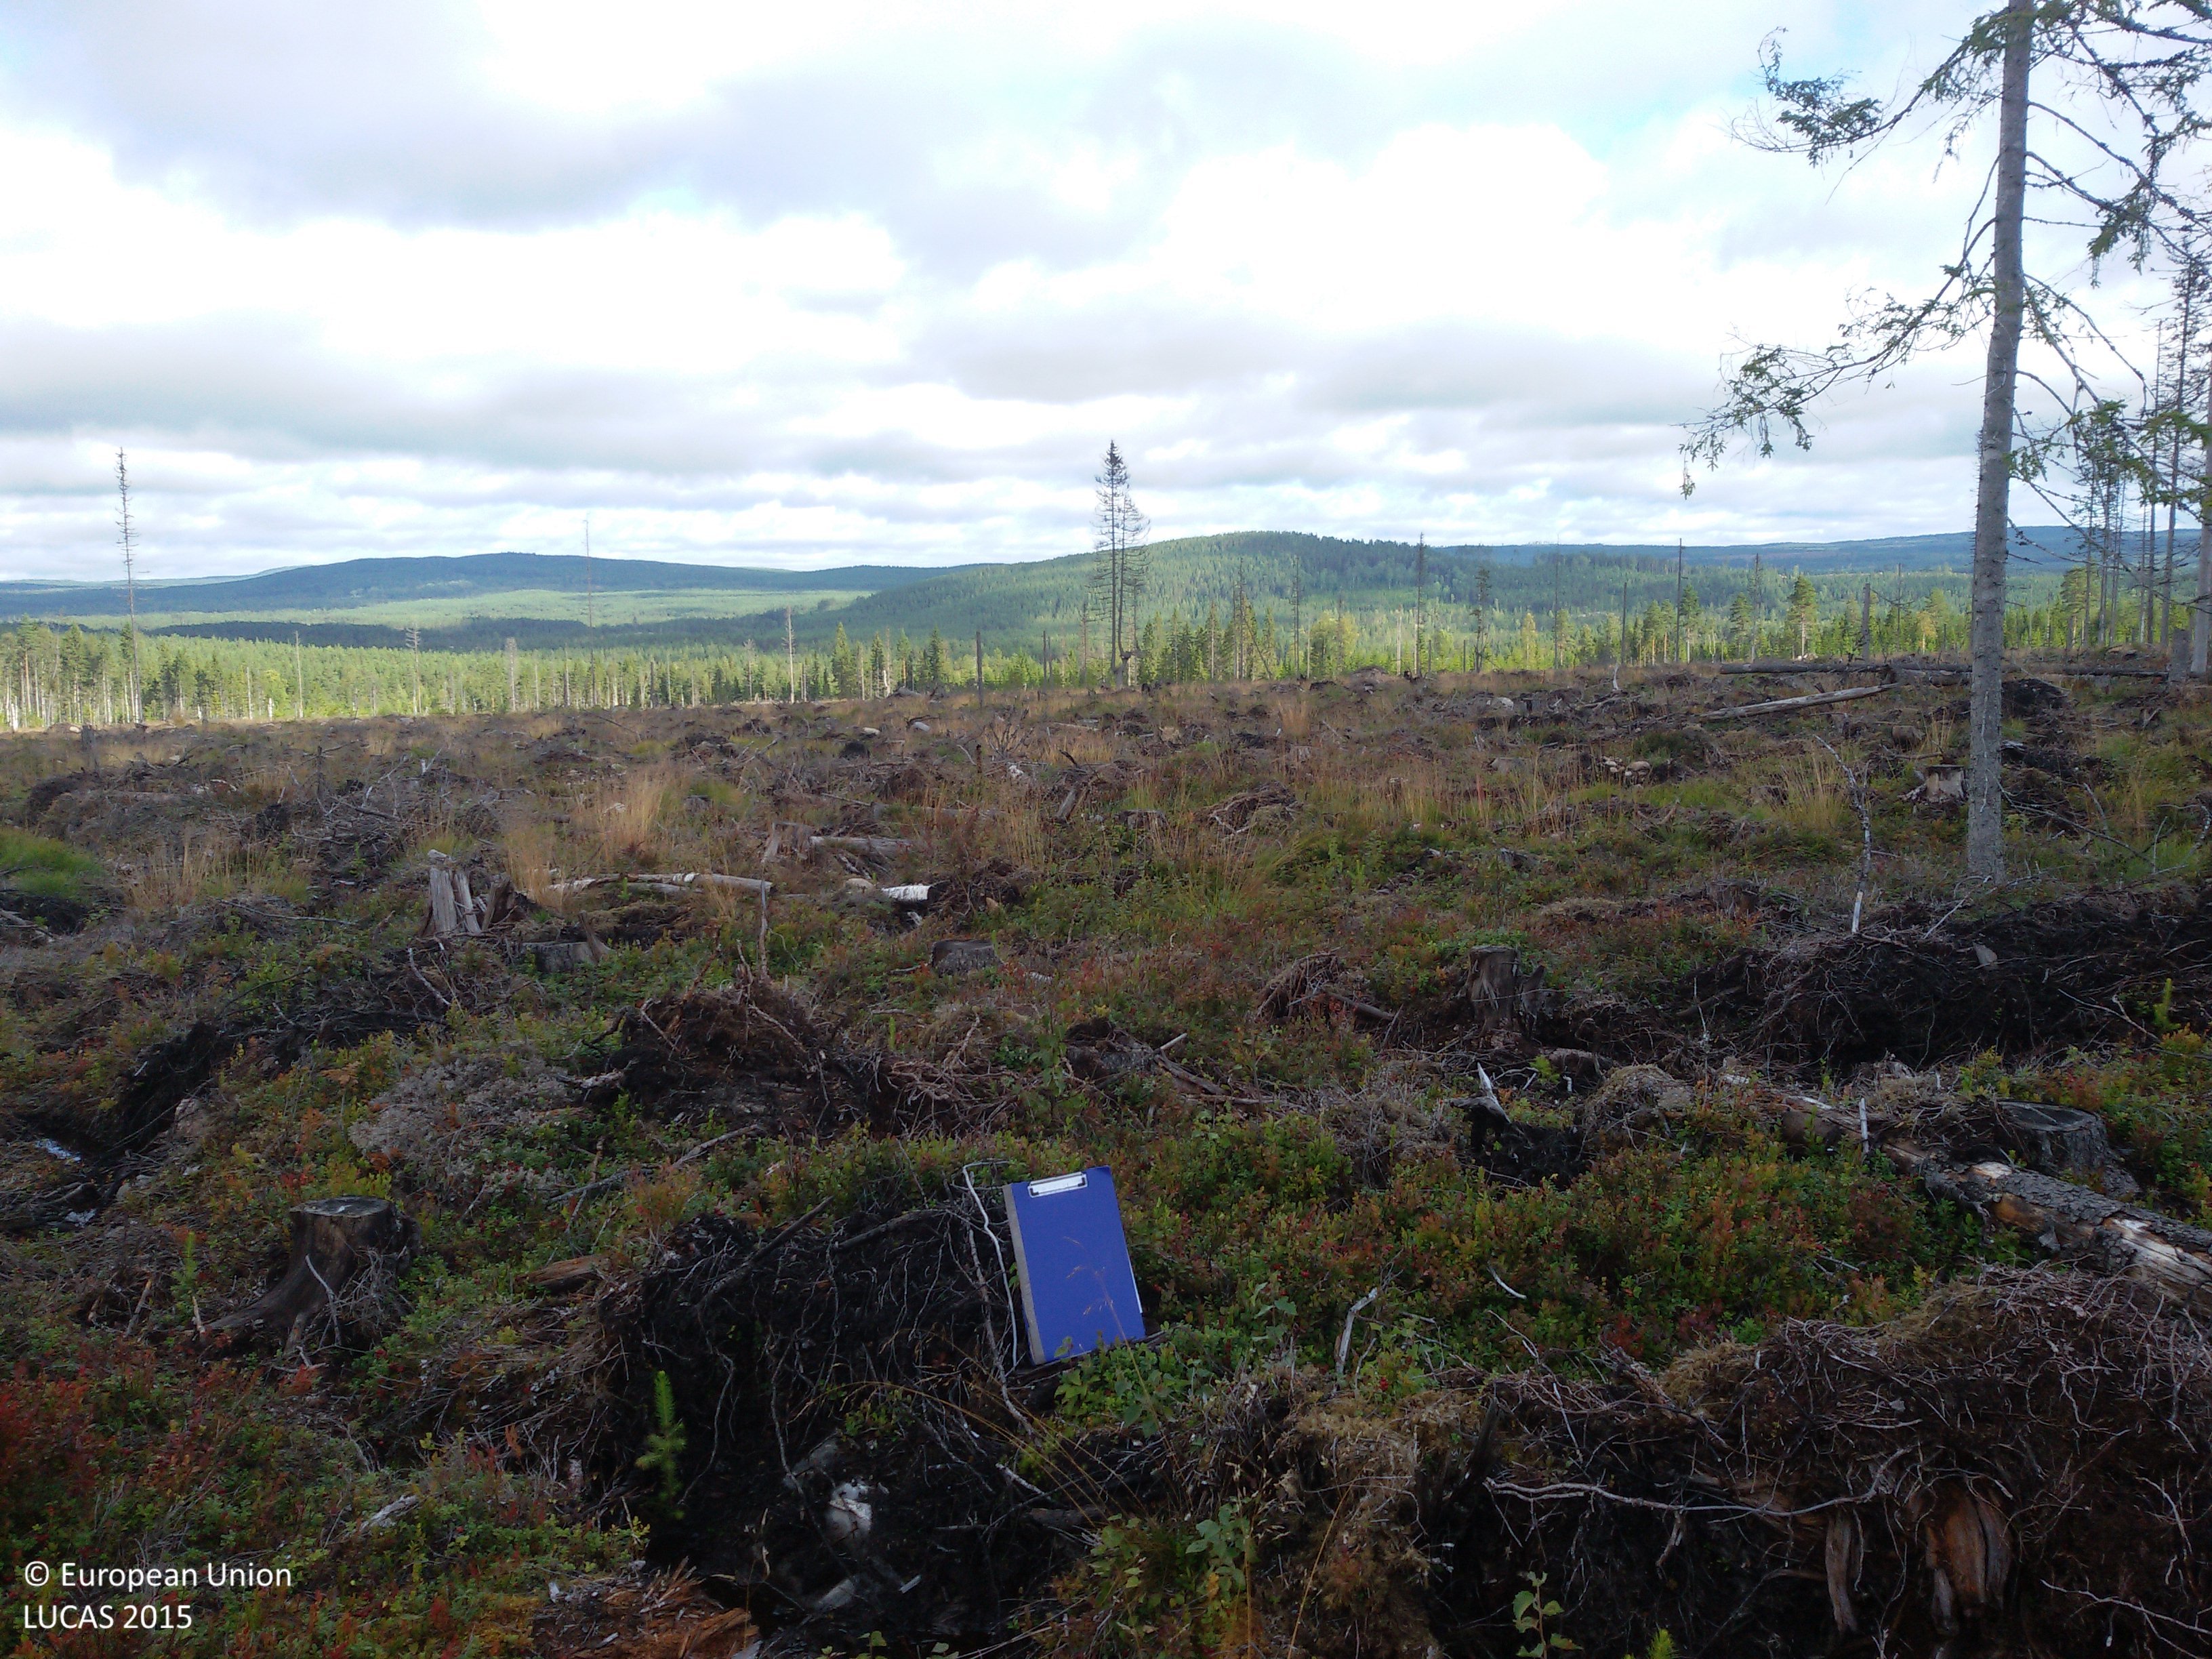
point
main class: Shrubland
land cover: Shrubland without tree cover
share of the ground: 10 - 25 %
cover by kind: herbaceous plants 40 %, lichens and mosses 30 %, unconsolidated bare surface 20 %, shrubs 10 %
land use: Forestry
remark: Clear cut
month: September
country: SE
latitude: 61.0158
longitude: 15.4063
